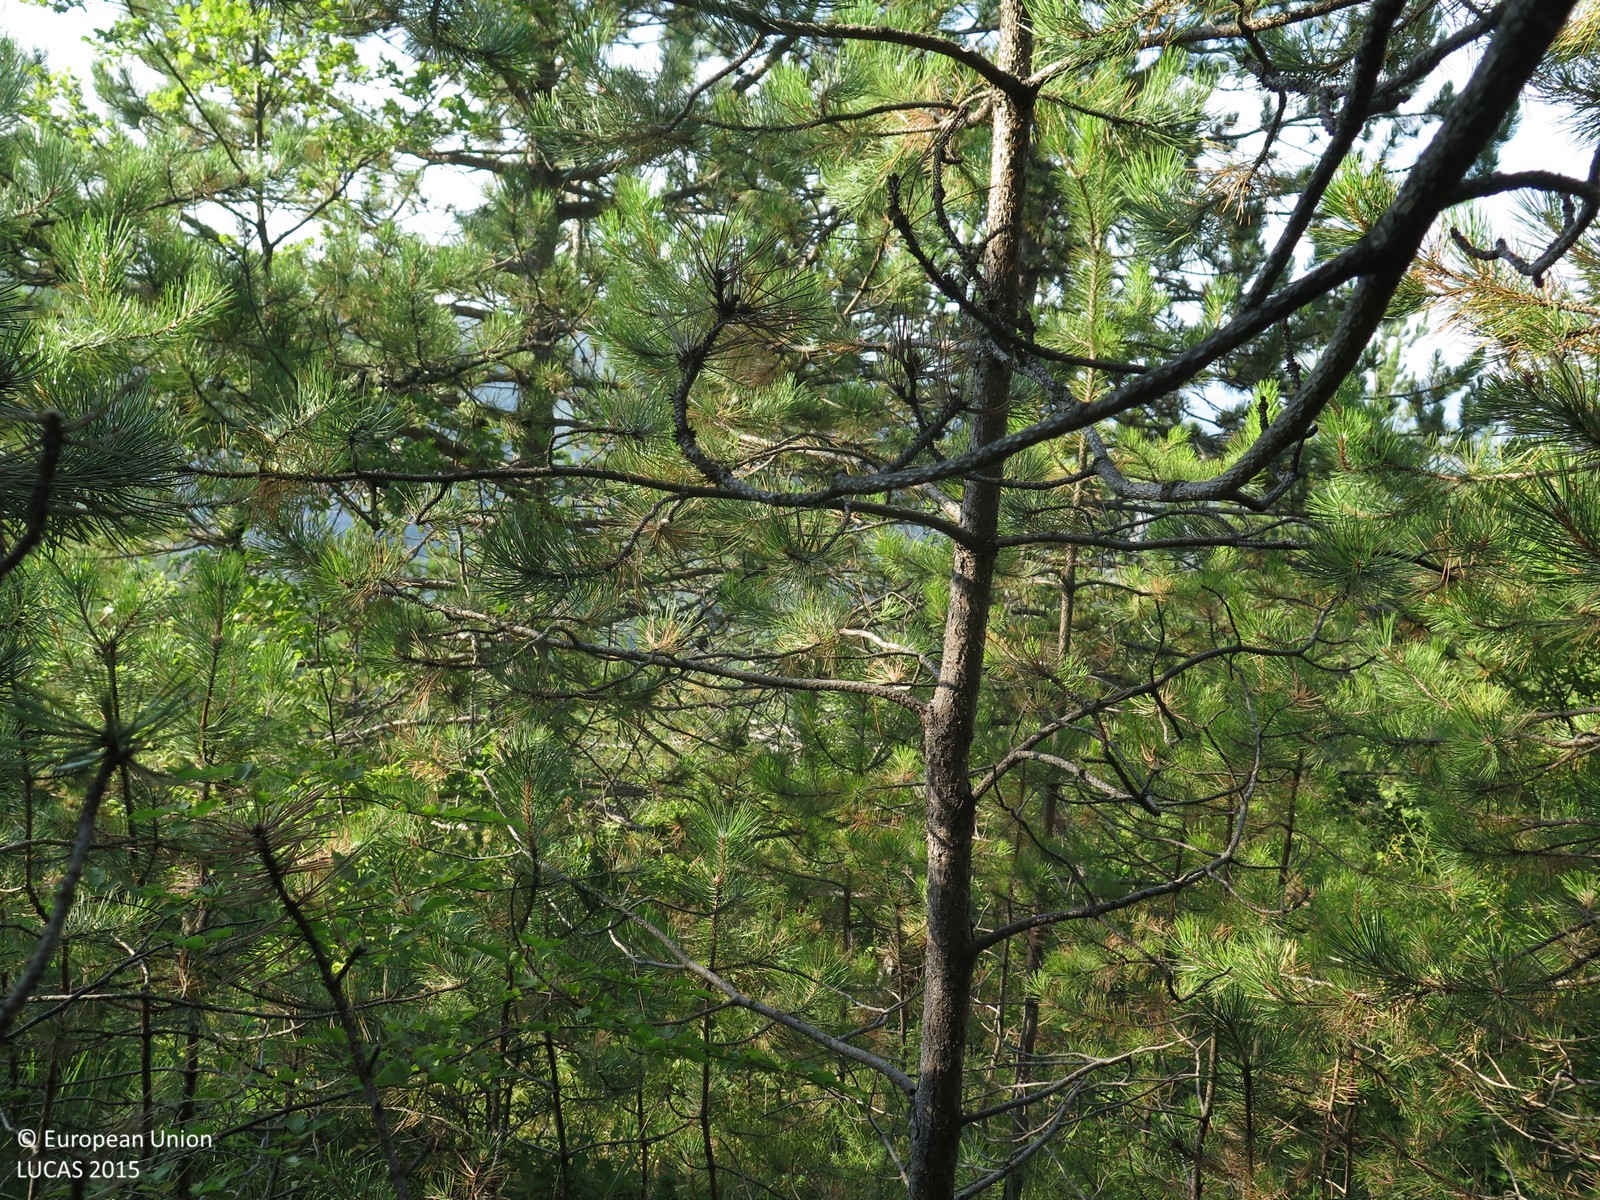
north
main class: Woodland
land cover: Pine dominated coniferous woodland
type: coniferous forest of the mediterranean region
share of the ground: > 75 %
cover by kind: coniferous forest trees 90 %, shrubs 5 %, herbaceous plants 5 %
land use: Semi-natural and natural areas not in use
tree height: > 5 m
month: July
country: HR
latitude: 45.3606
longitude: 13.8887
